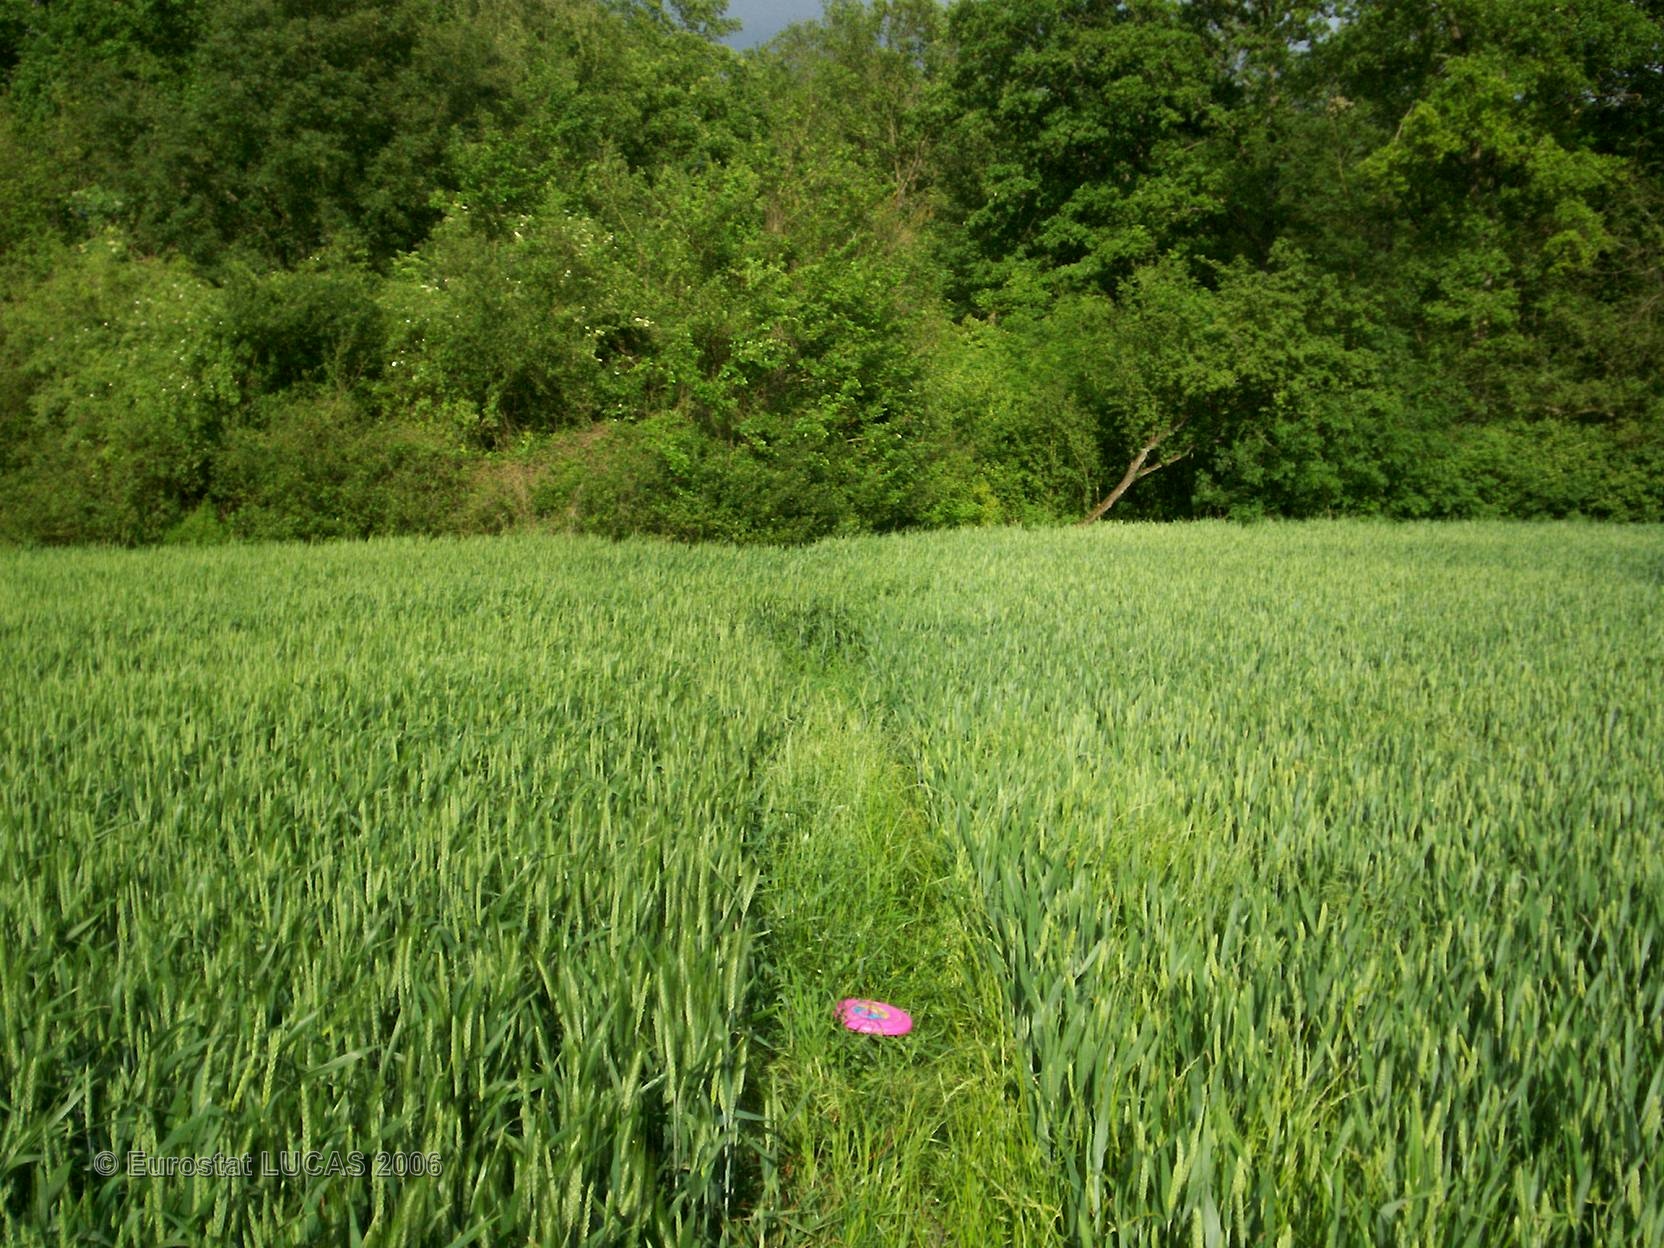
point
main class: Cropland
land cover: Common wheat
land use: Agriculture (excluding fallow land and kitchen gardens)
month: May
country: FR
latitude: 48.9074
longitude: 2.7727
